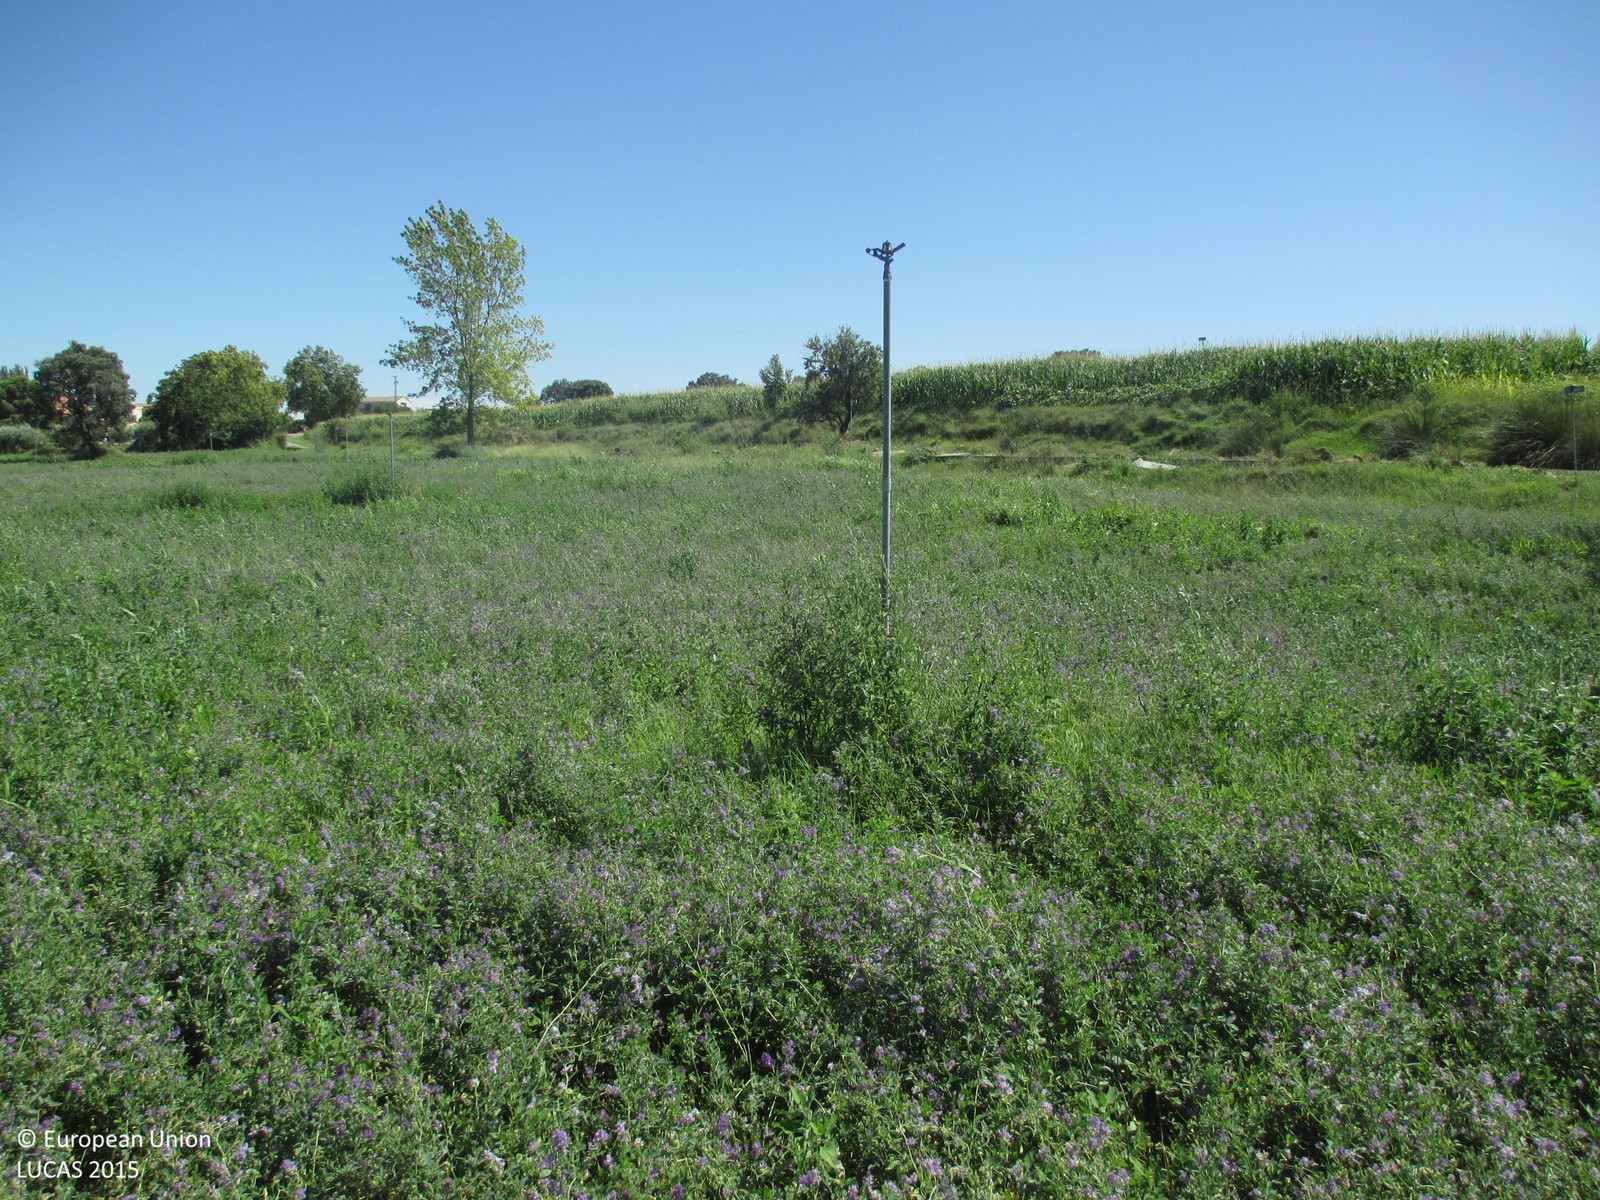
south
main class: Cropland
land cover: Lucerne
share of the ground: > 75 %
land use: Agriculture (excluding fallow land and kitchen gardens)
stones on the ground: < 10 %
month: July
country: ES
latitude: 41.9273
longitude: 0.0576
